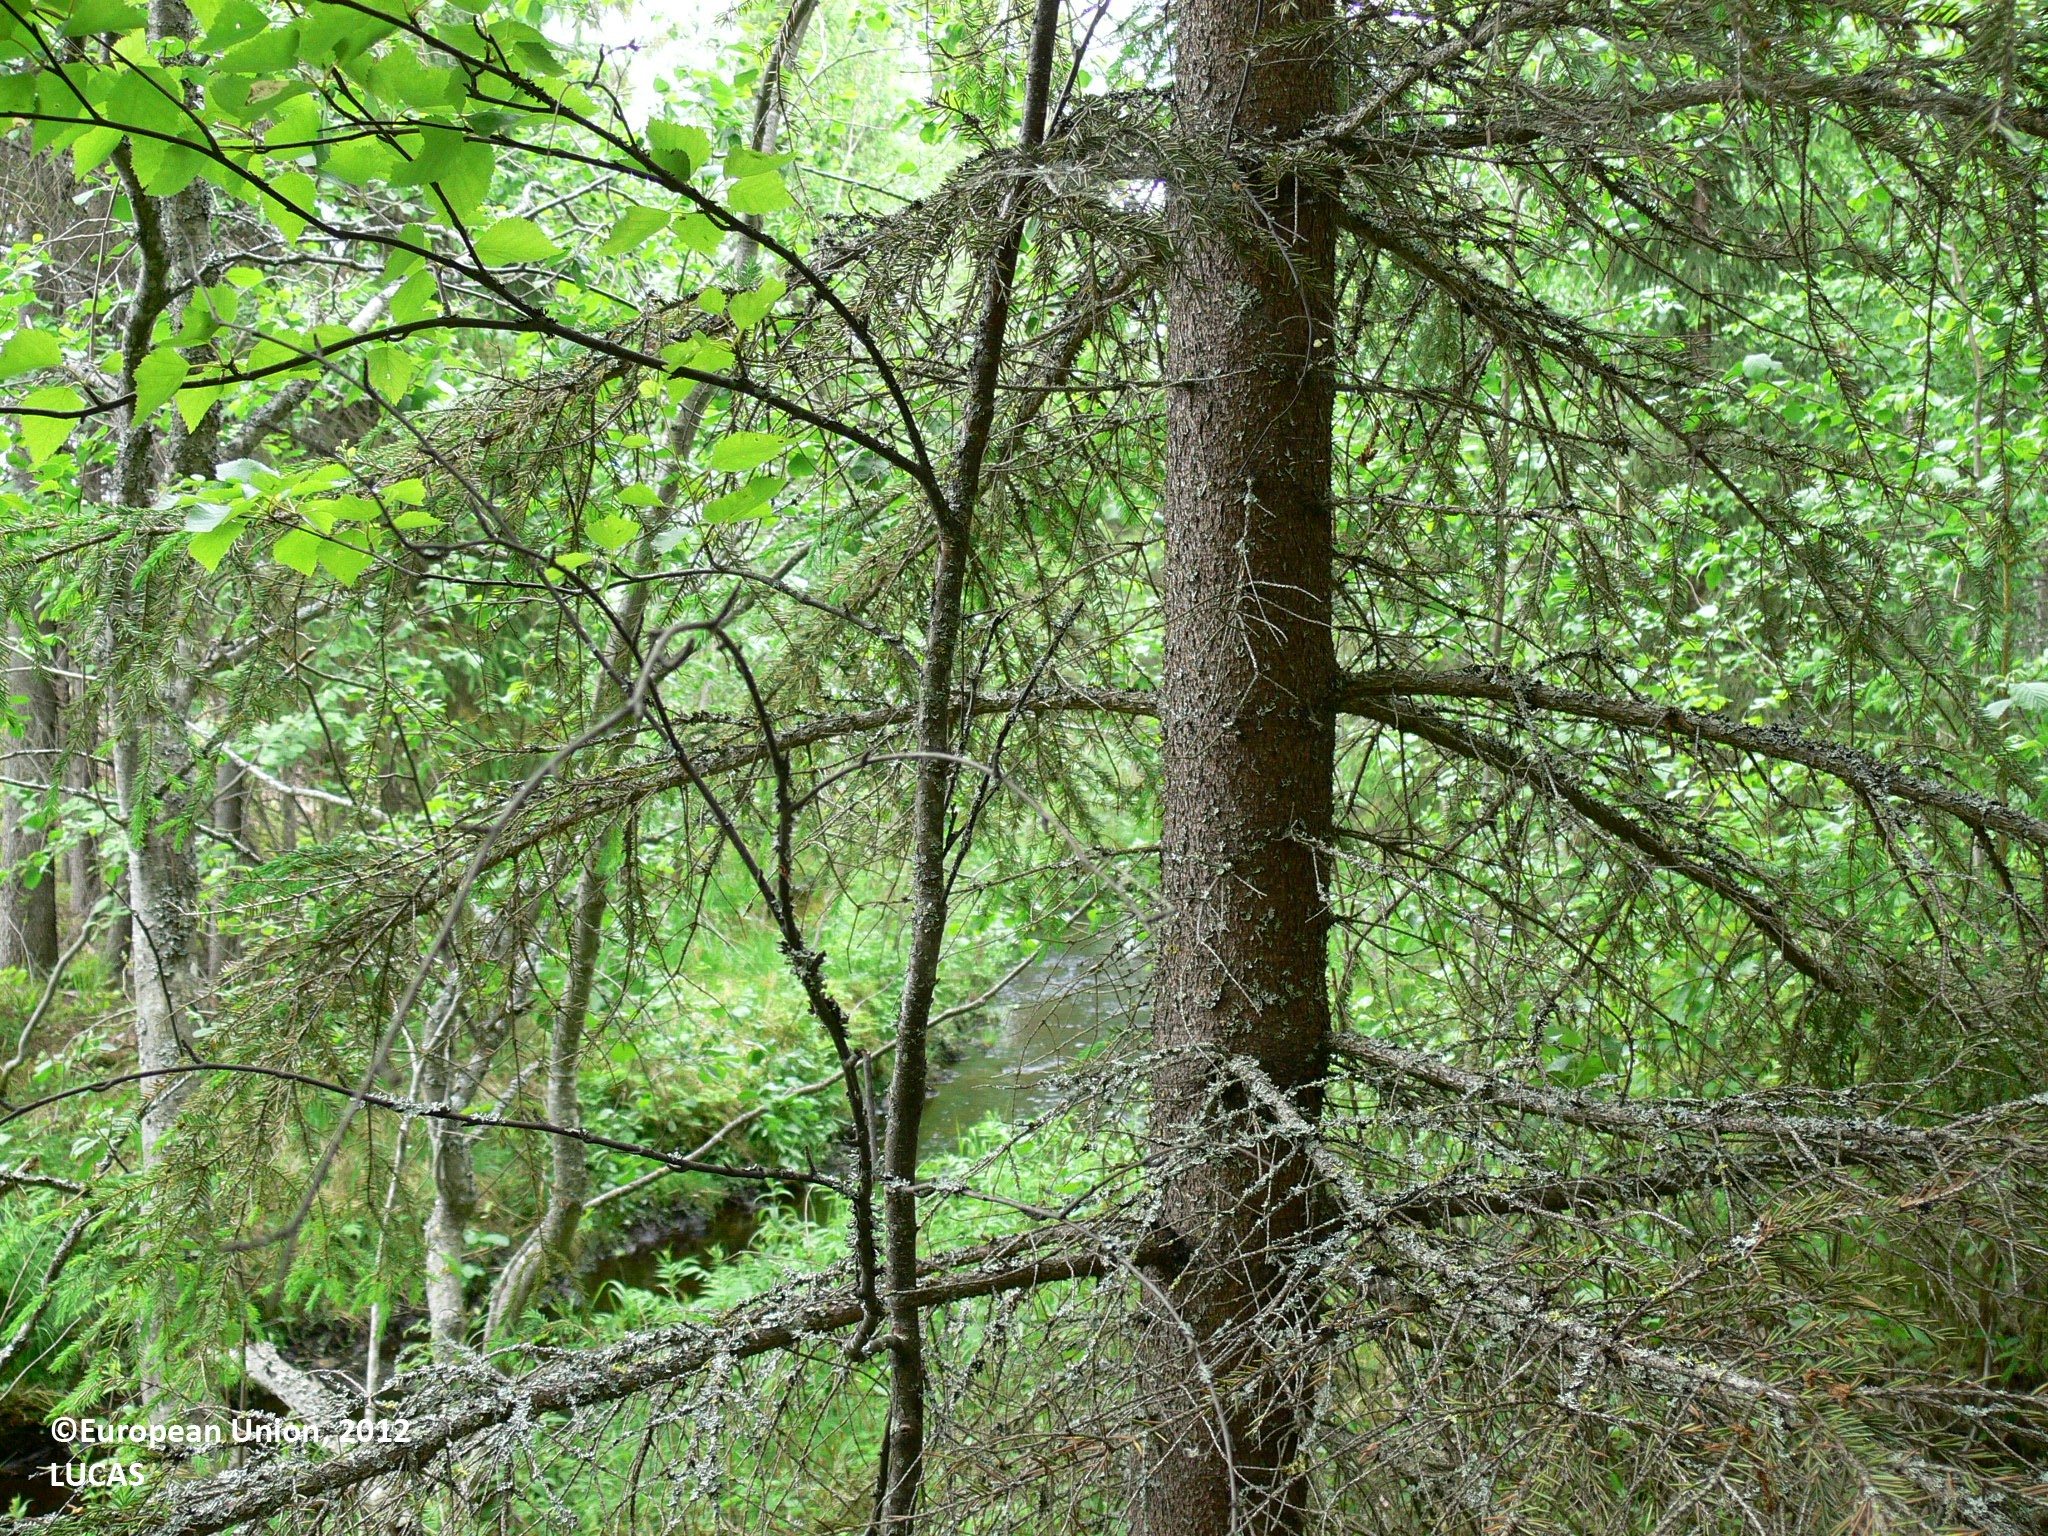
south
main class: Woodland
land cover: Spruce dominated mixed woodland
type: boreal forest
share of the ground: > 75 %
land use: Forestry
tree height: > 5 m
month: June
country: FI
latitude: 63.0229
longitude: 29.7455
